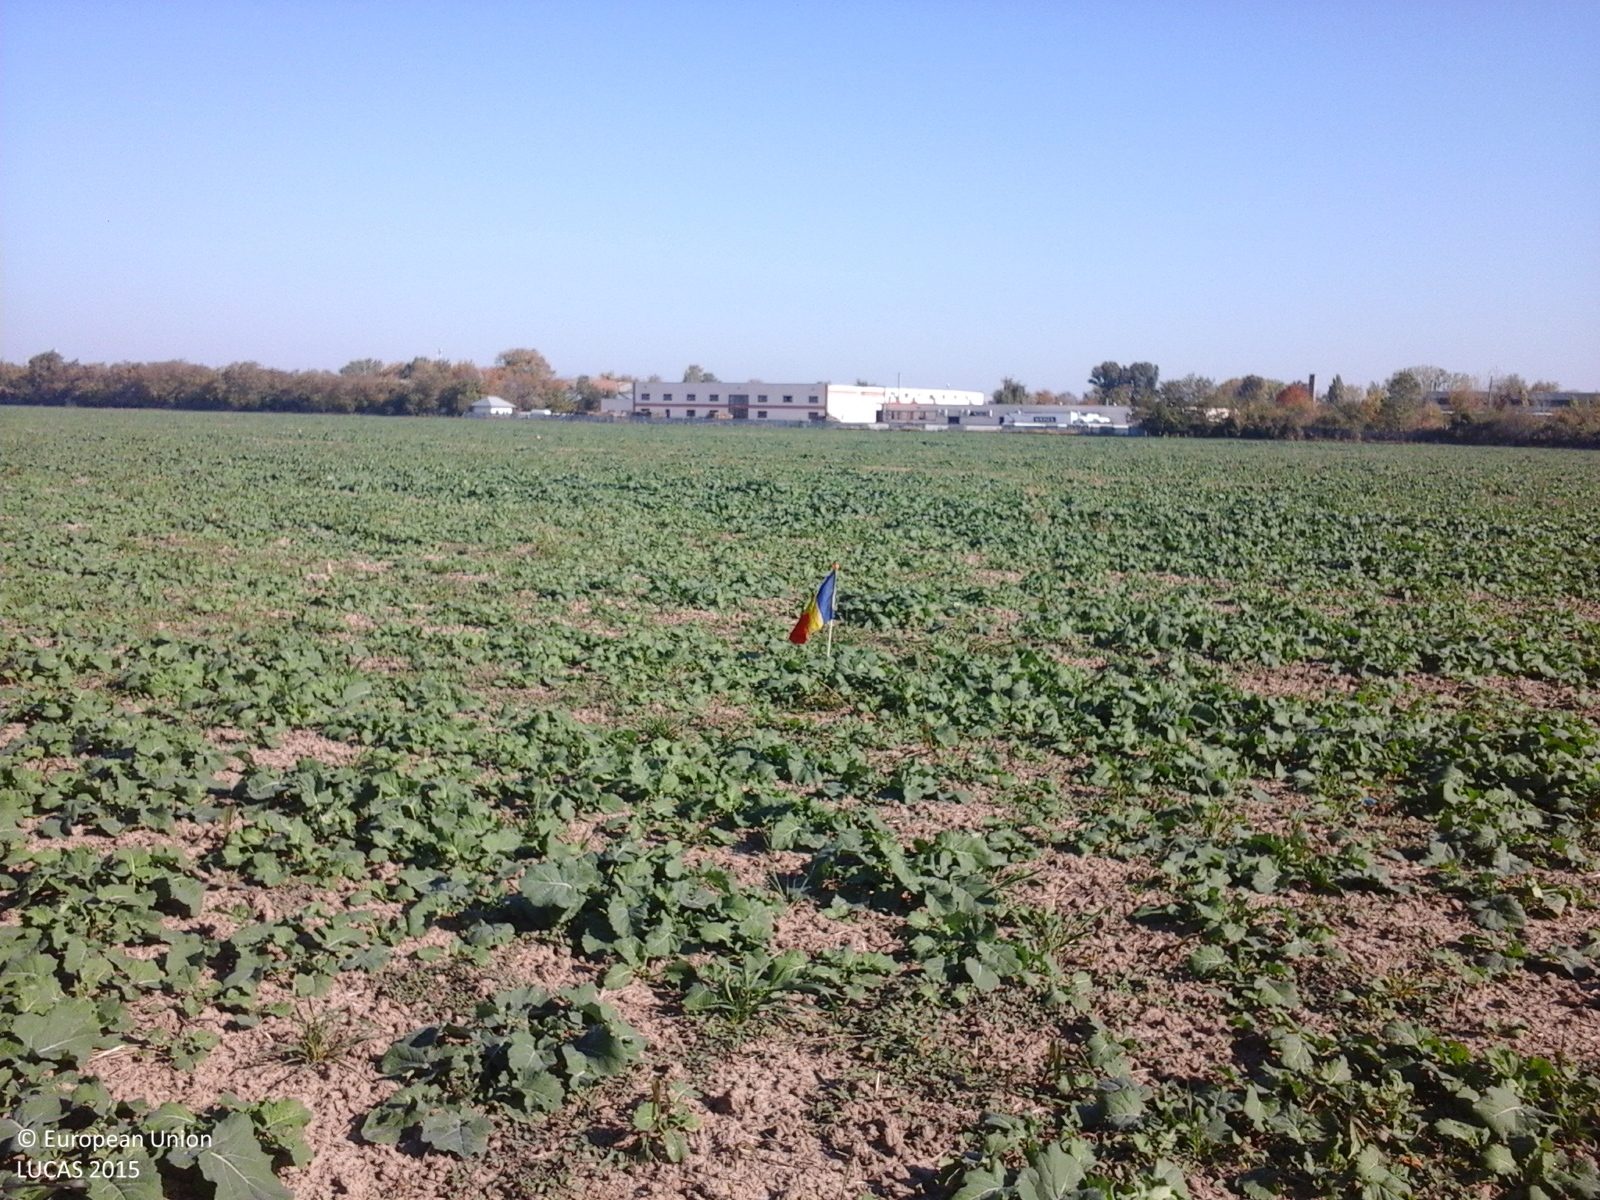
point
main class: Cropland
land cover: Rape and turnip rape
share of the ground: > 75 %
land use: Agriculture (excluding fallow land and kitchen gardens)
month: October
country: RO
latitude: 45.7047
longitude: 27.1643
